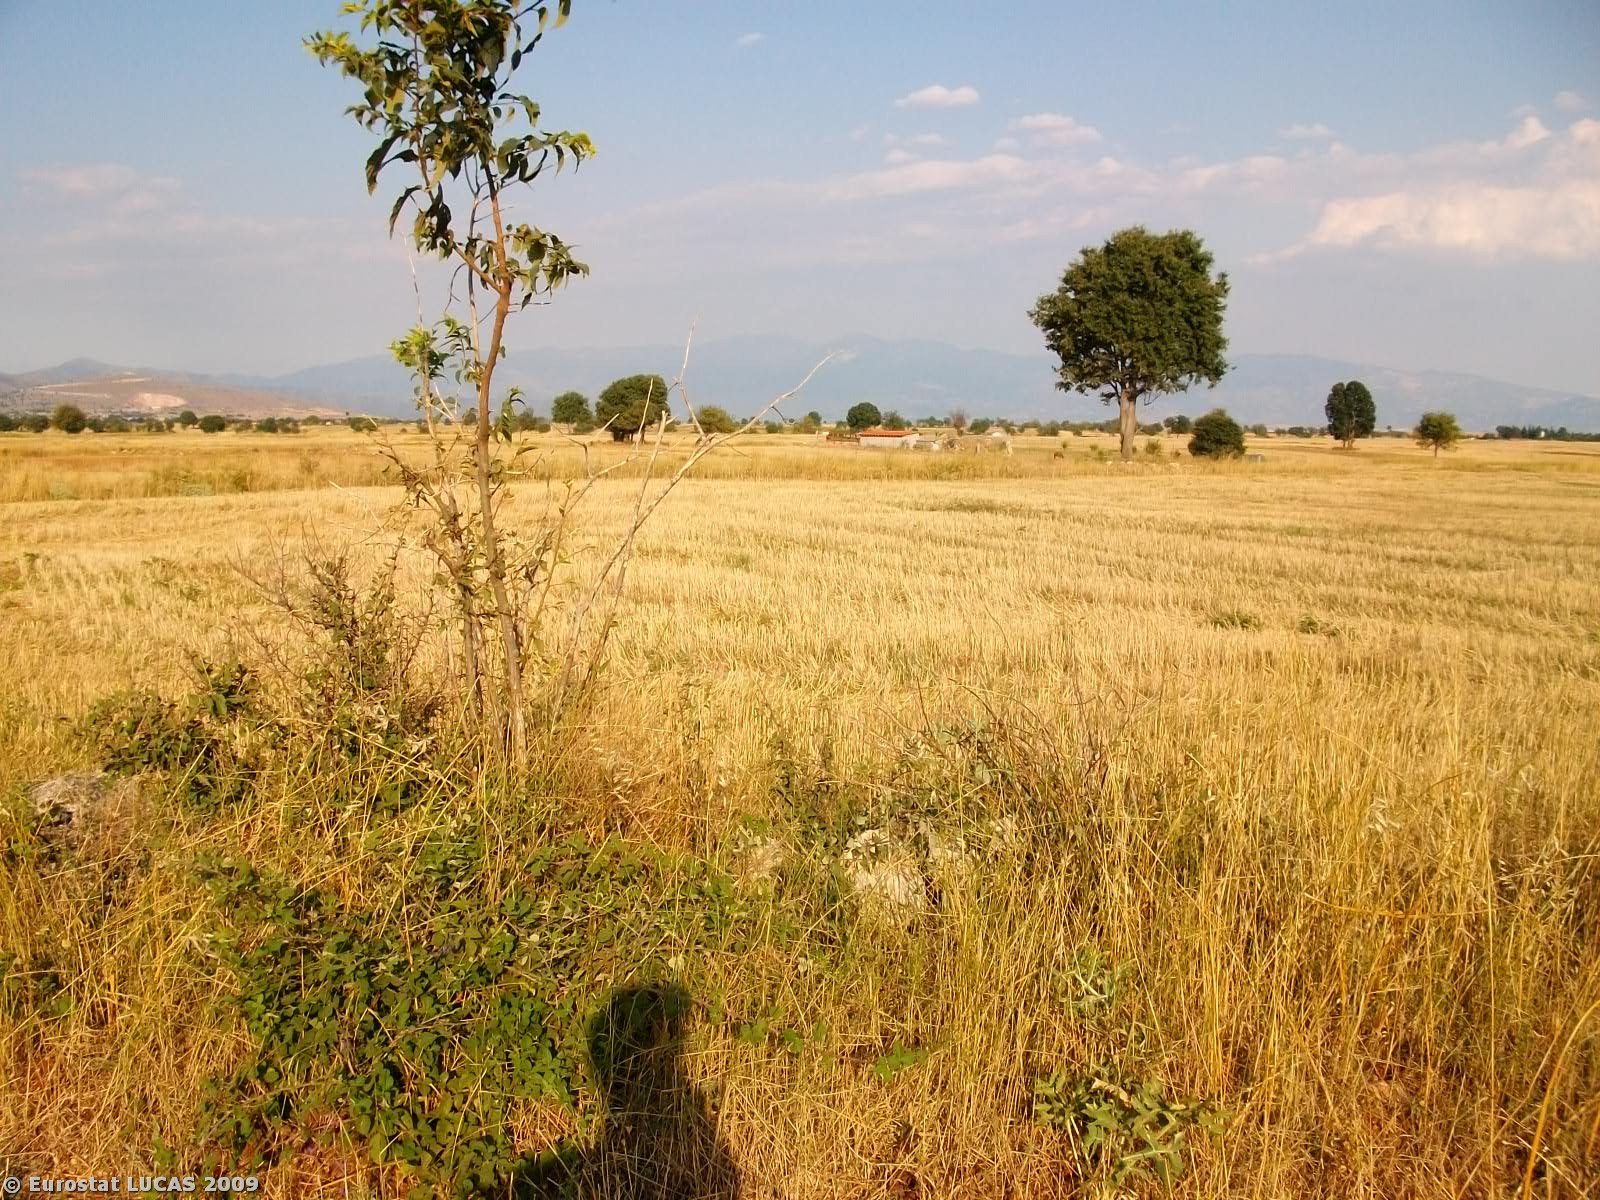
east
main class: Cropland
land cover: Durum wheat
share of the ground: < 10 %
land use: Agriculture (excluding fallow land and kitchen gardens)
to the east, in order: Durum wheat; Grass margins; Durum wheat; Dry stone walls; Durum wheat; Grass margins; Paved roads, cycling and walking lanes; Dry stone walls; Bare land; Grass margins; Common wheat; Grass margins; Durum wheat
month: July
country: GR
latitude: 40.2816
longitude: 21.8124
